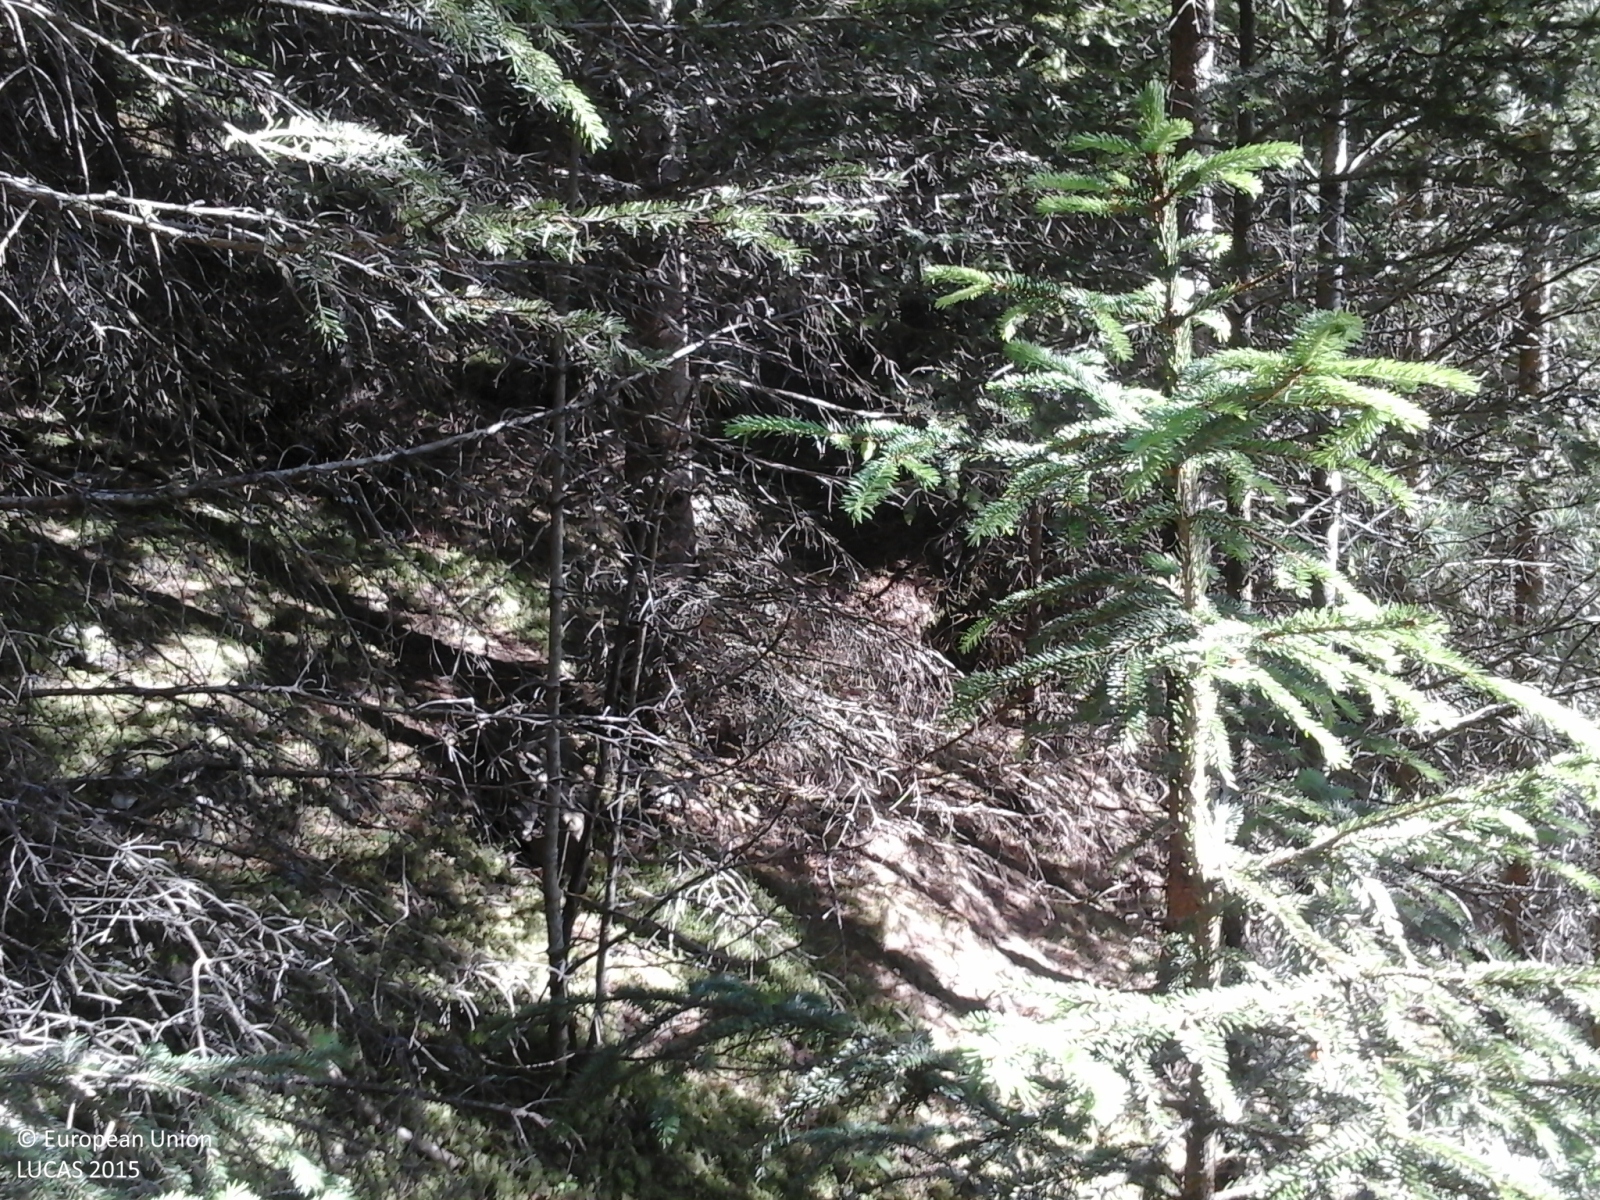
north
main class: Woodland
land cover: Spruce dominated coniferous woodland
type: alpine coniferous forest
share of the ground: > 75 %
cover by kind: coniferous forest trees 100 %
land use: Forestry
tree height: > 5 m
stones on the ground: 25 - 50 %
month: June
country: IT
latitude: 46.6994
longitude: 11.6068
